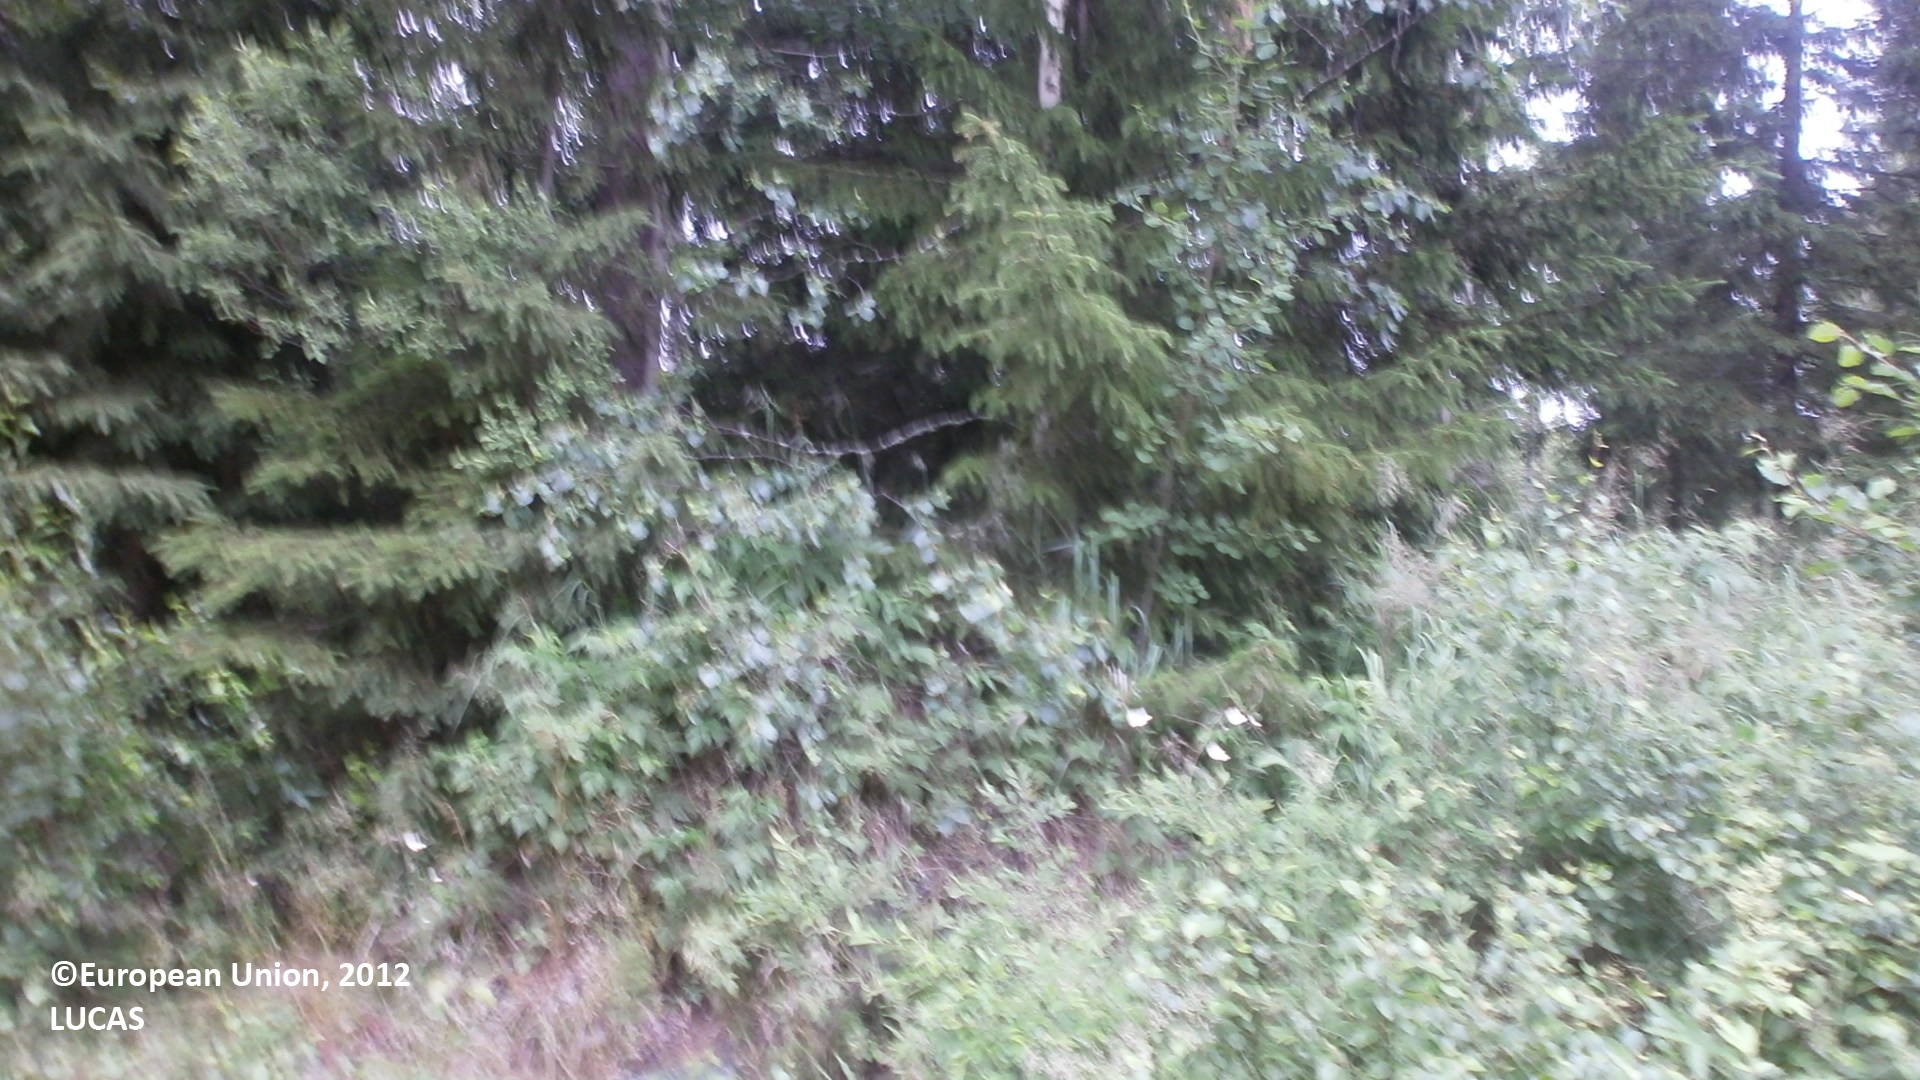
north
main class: Woodland
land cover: Broadleaved woodland
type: boreal forest
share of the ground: 50 - 75 %
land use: Energy production
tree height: < 5 m
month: July
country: FI
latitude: 64.5860
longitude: 24.5842
